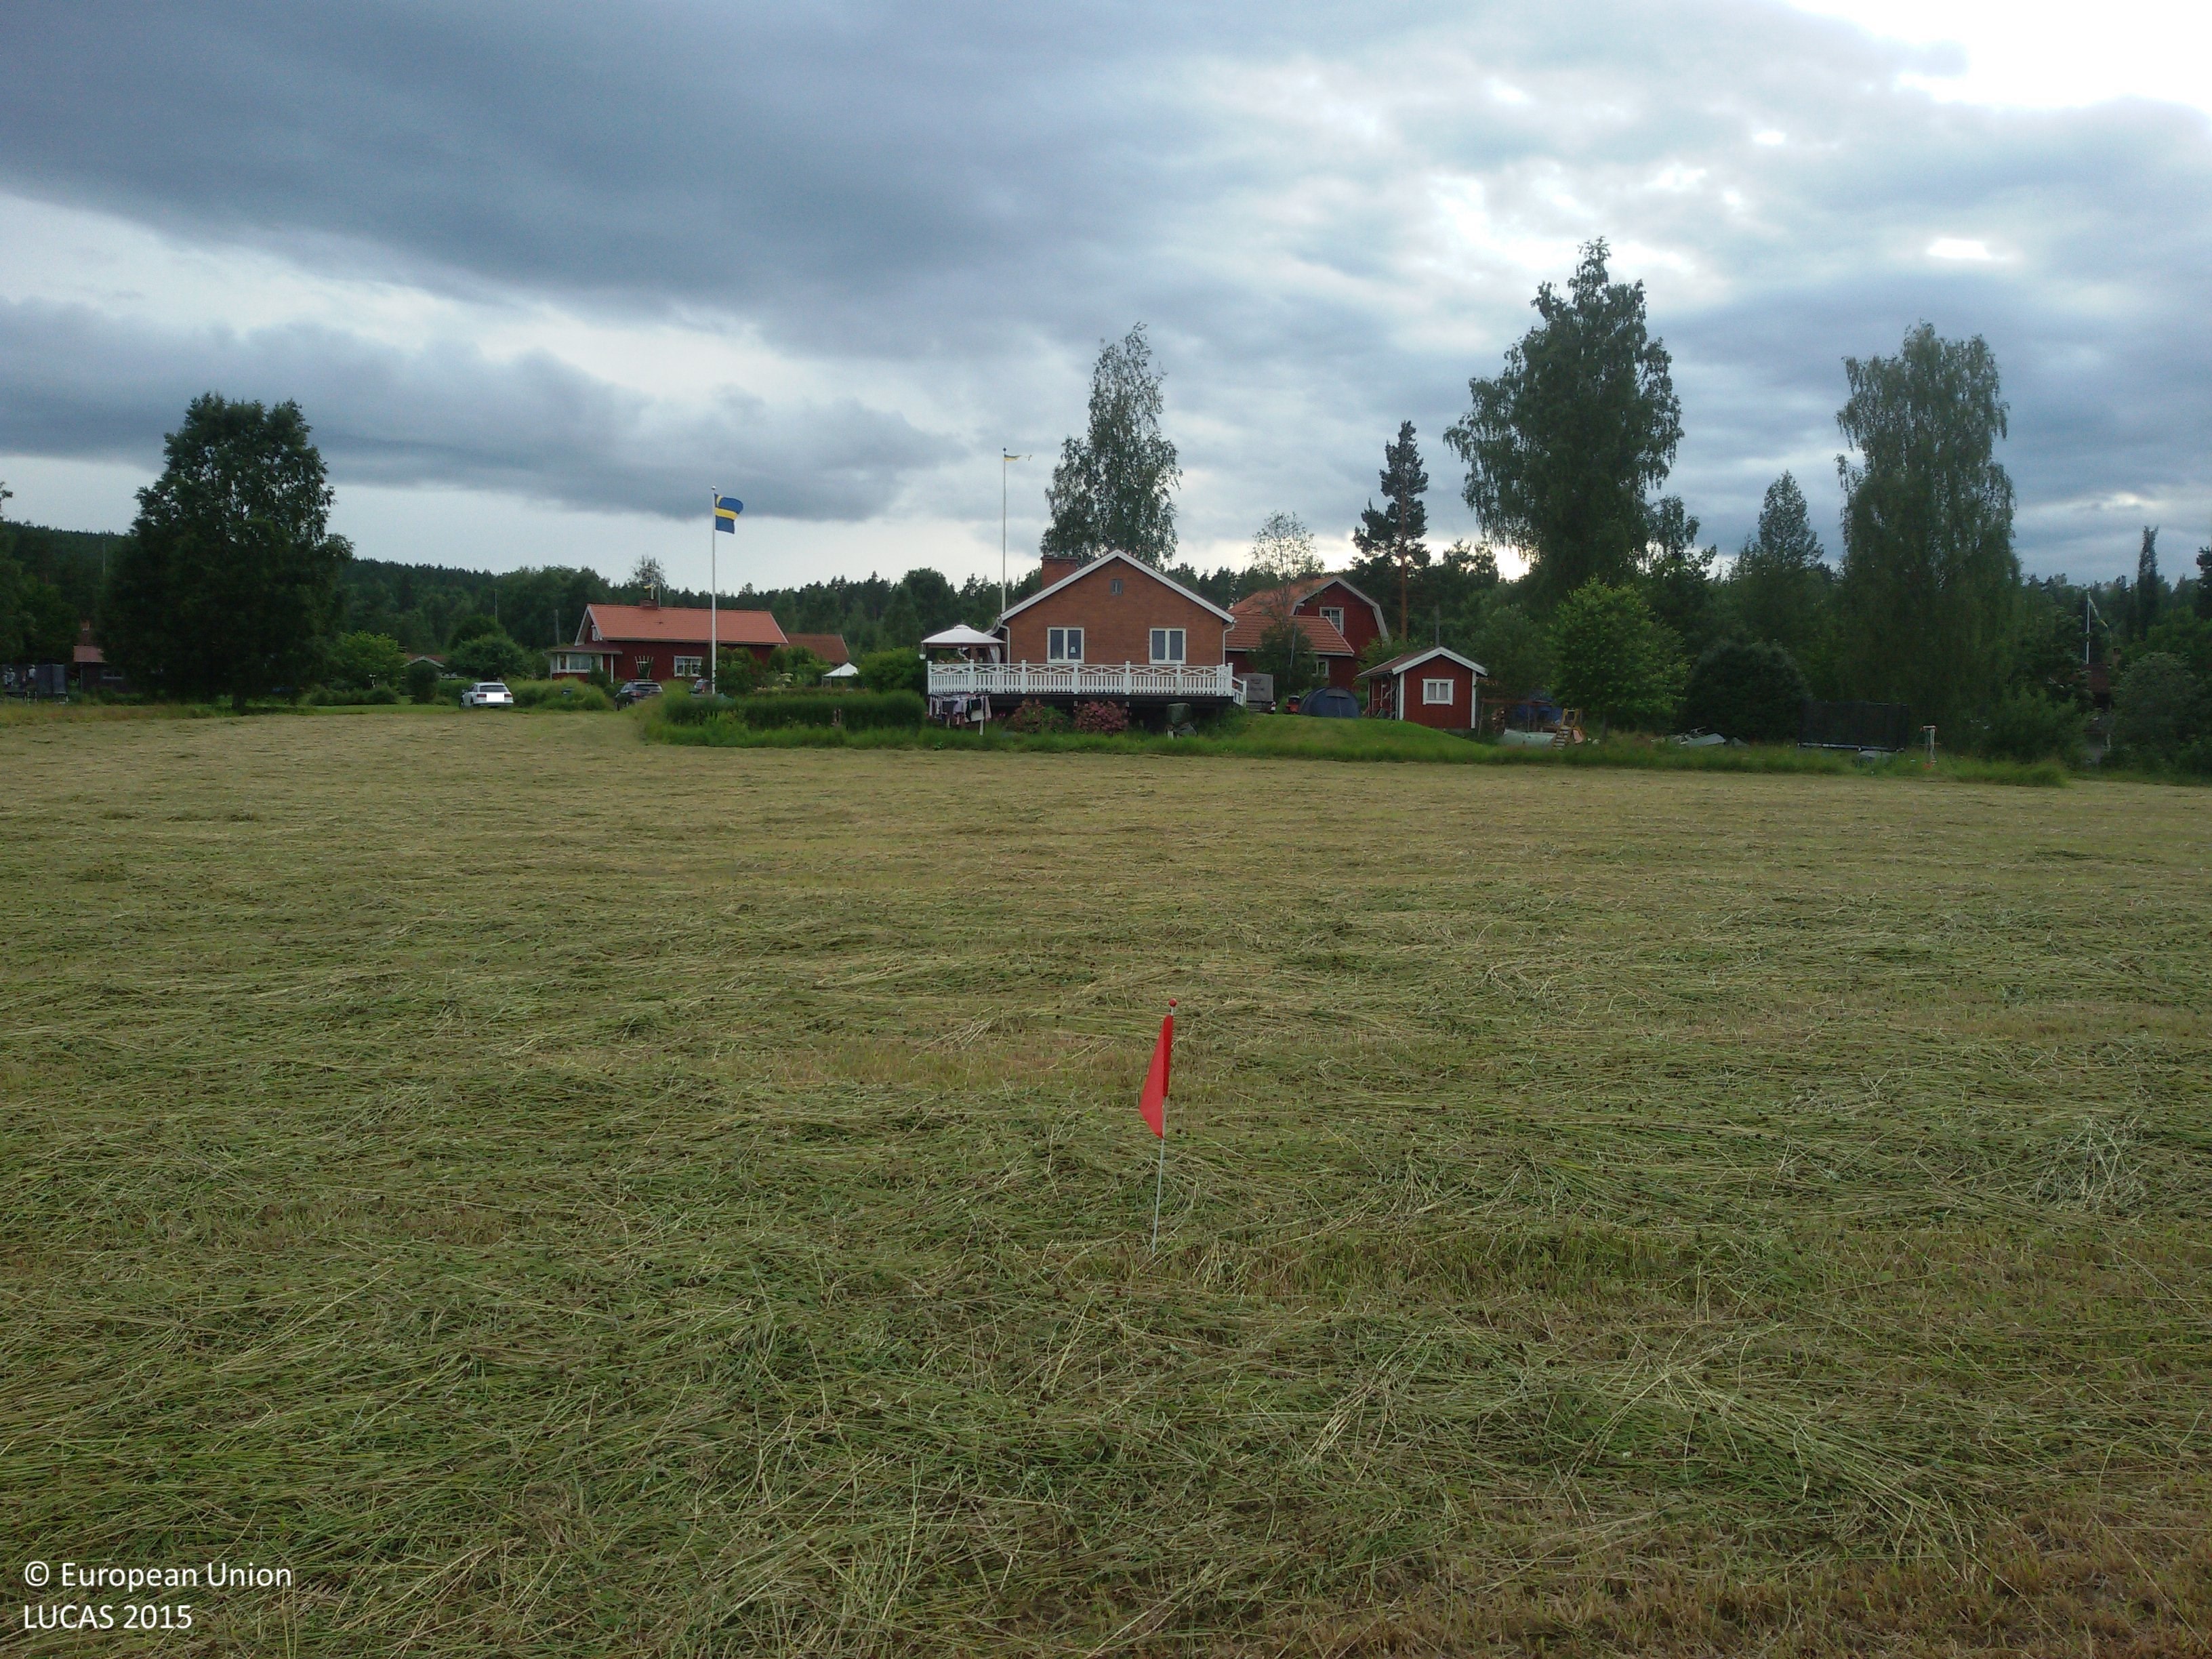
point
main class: Cropland
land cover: Temporary grasslands
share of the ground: > 75 %
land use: Agriculture (excluding fallow land and kitchen gardens)
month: July
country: SE
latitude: 60.6855
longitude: 15.0591
